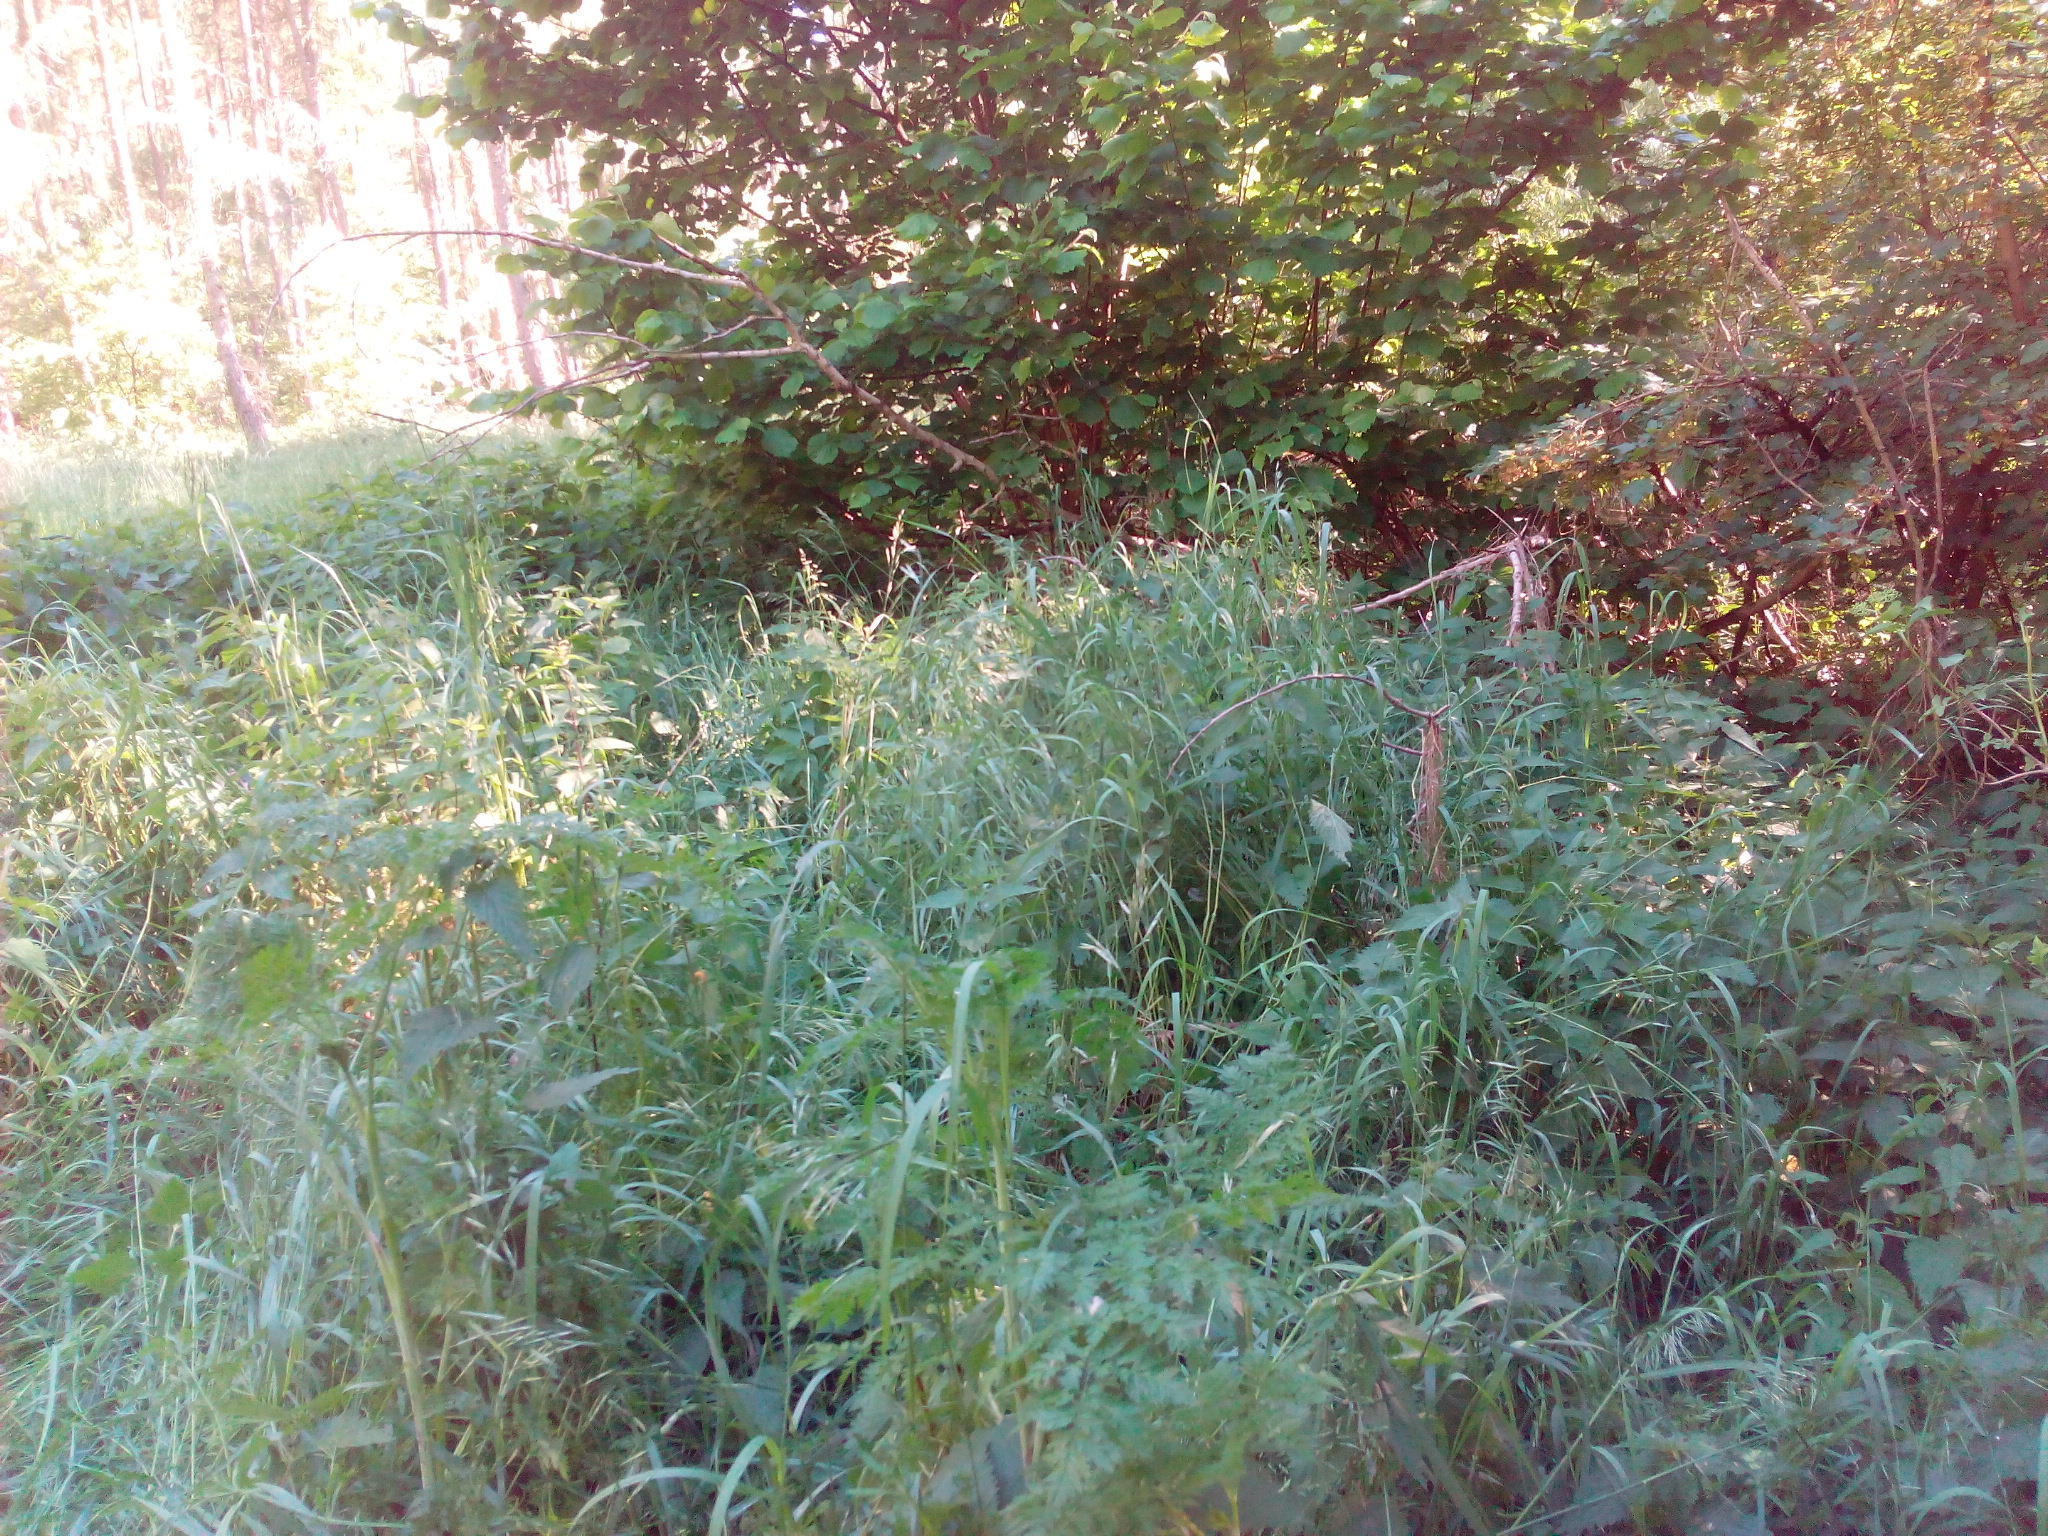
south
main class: Woodland
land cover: Broadleaved woodland
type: mesophytic deciduous forest
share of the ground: 25 - 50 %
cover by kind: broadleaved forest trees 40 %, herbaceous plants 30 %, shrubs 20 %, coniferous forest trees 10 %
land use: Forestry
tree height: > 5 m
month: June
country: DE
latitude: 53.1322
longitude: 14.1708
